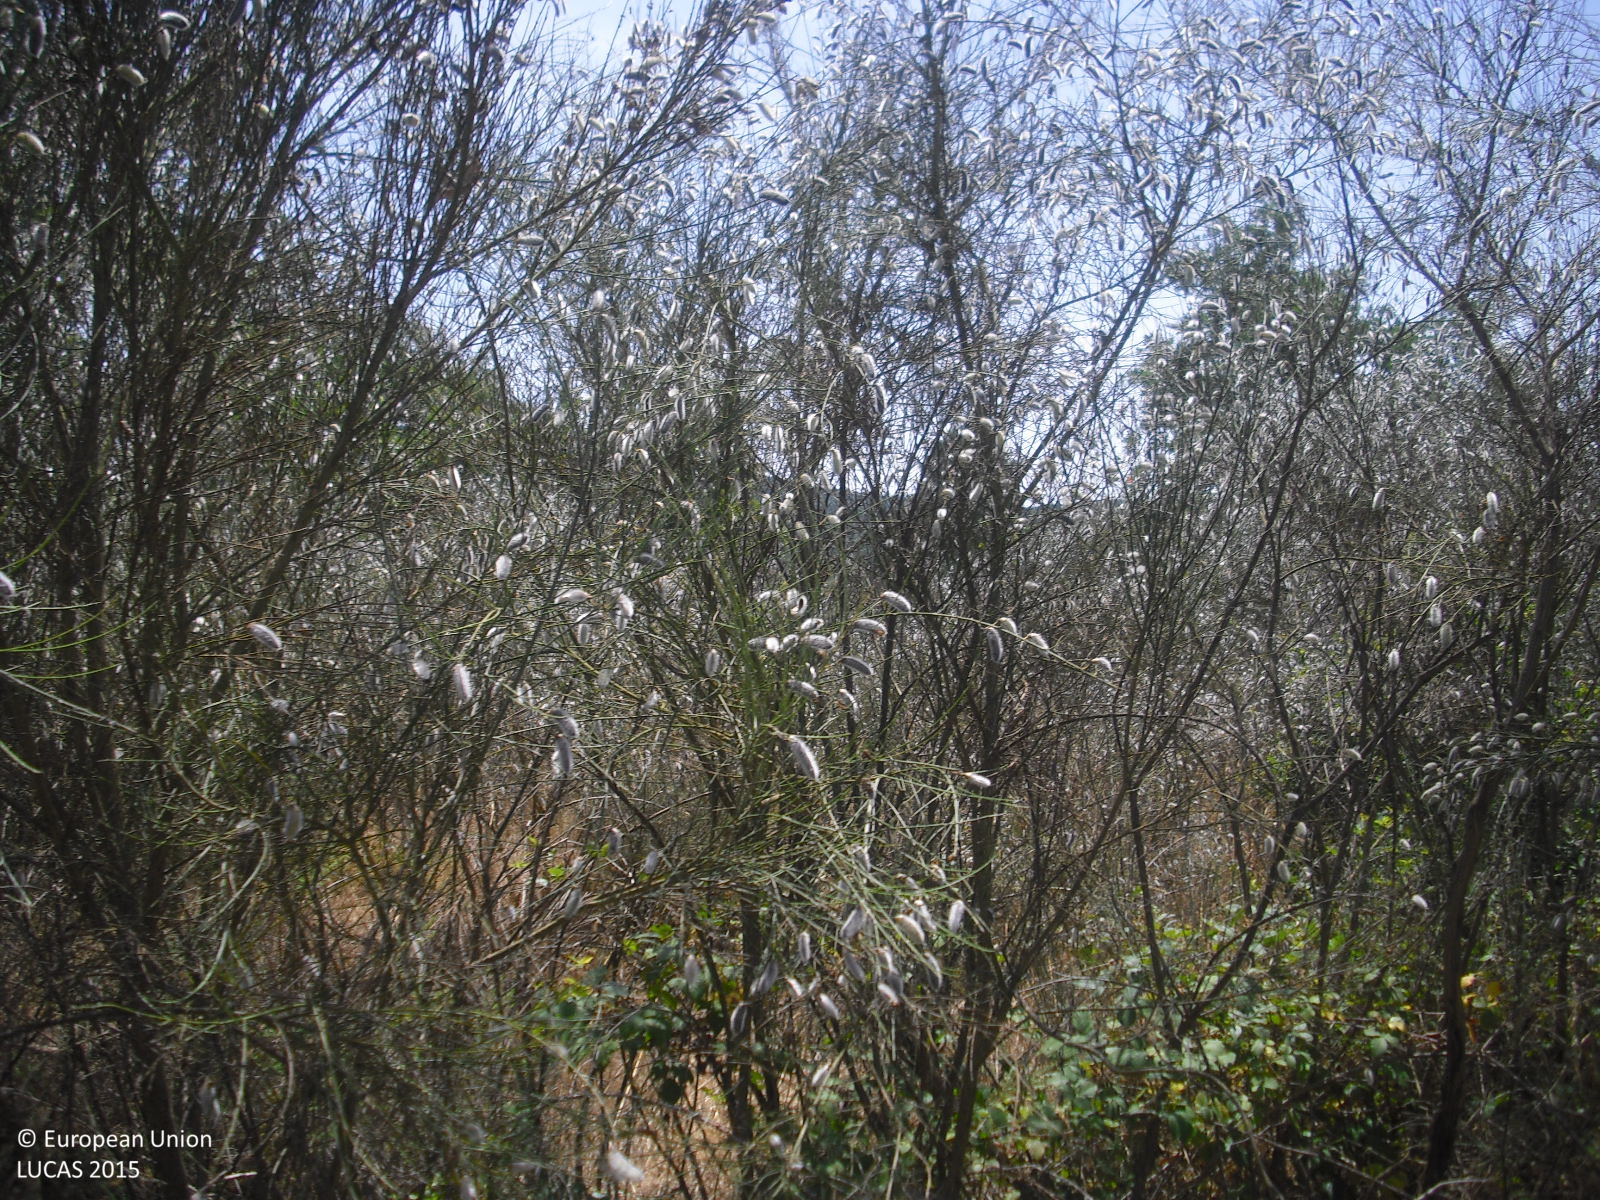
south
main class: Shrubland
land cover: Shrubland without tree cover
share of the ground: 50 - 75 %
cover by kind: shrubs 70 %, herbaceous plants 30 %
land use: Abandoned areas
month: July
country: ES
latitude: 42.4979
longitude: -7.5062
